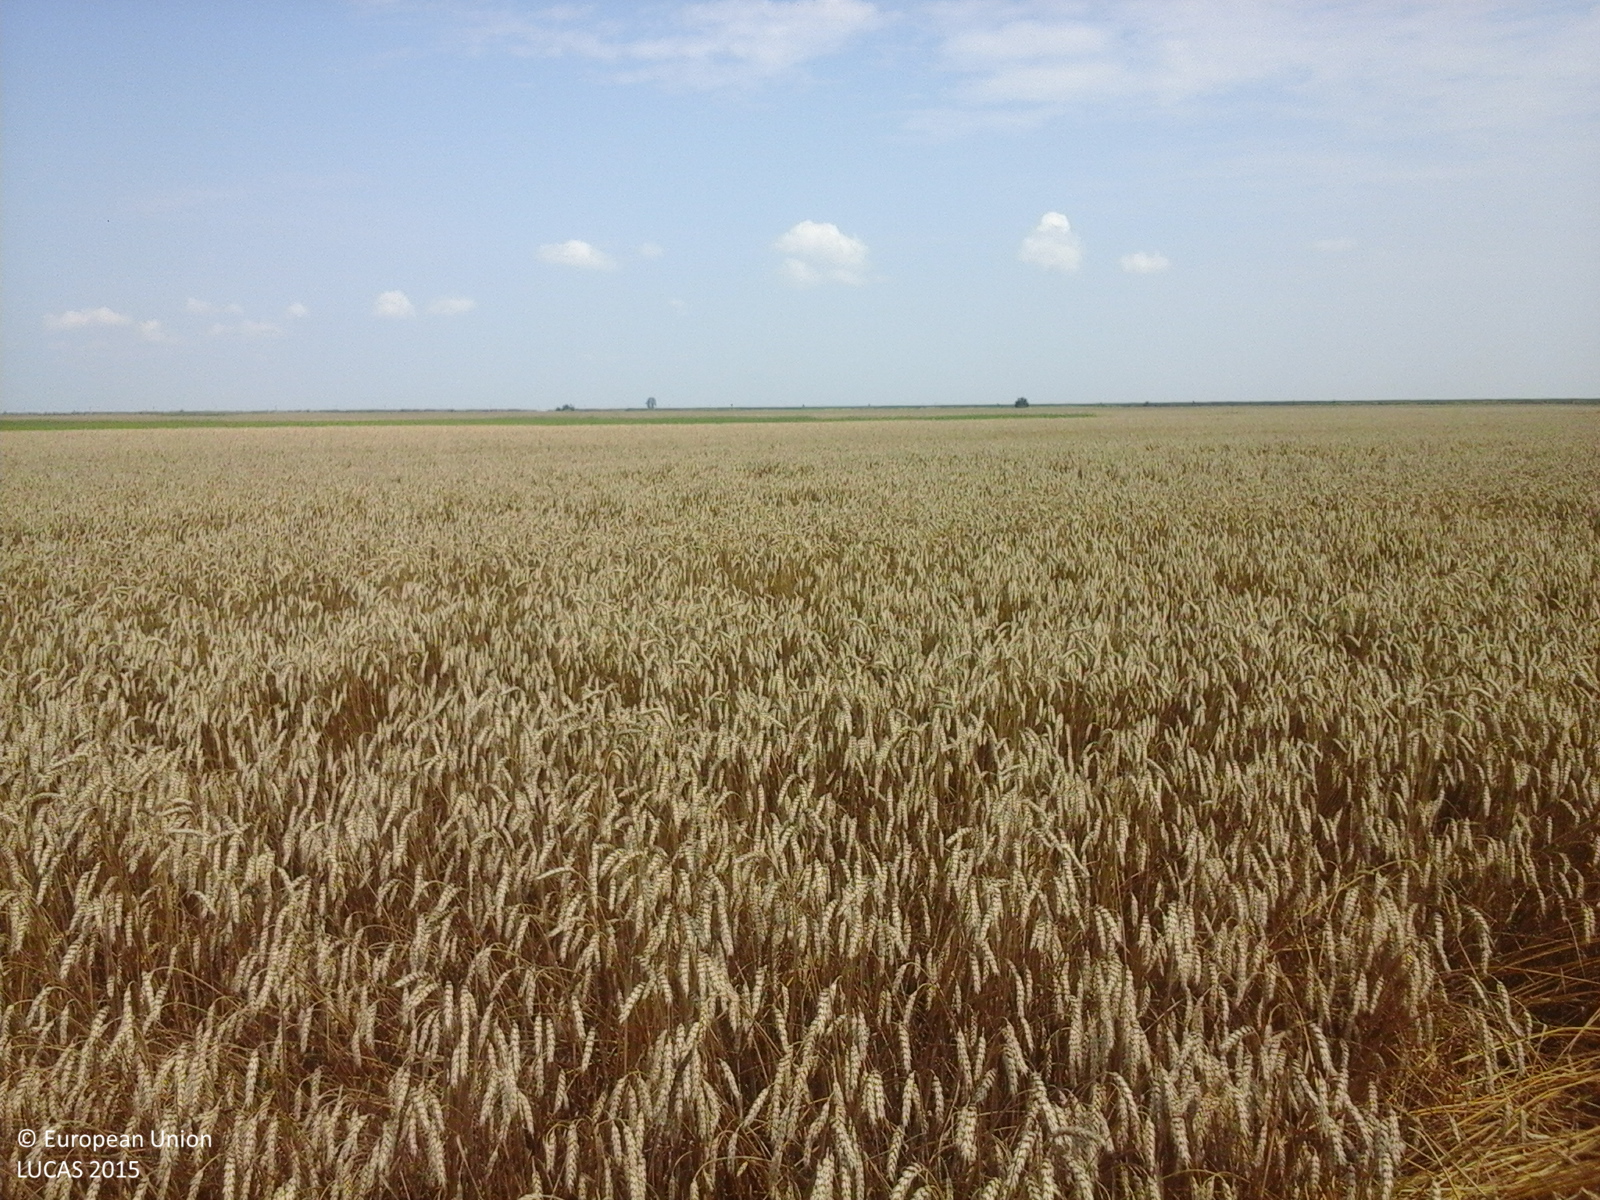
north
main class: Cropland
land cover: Common wheat
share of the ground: > 75 %
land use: Agriculture (excluding fallow land and kitchen gardens)
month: July
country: RO
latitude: 44.0219
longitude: 25.4941
